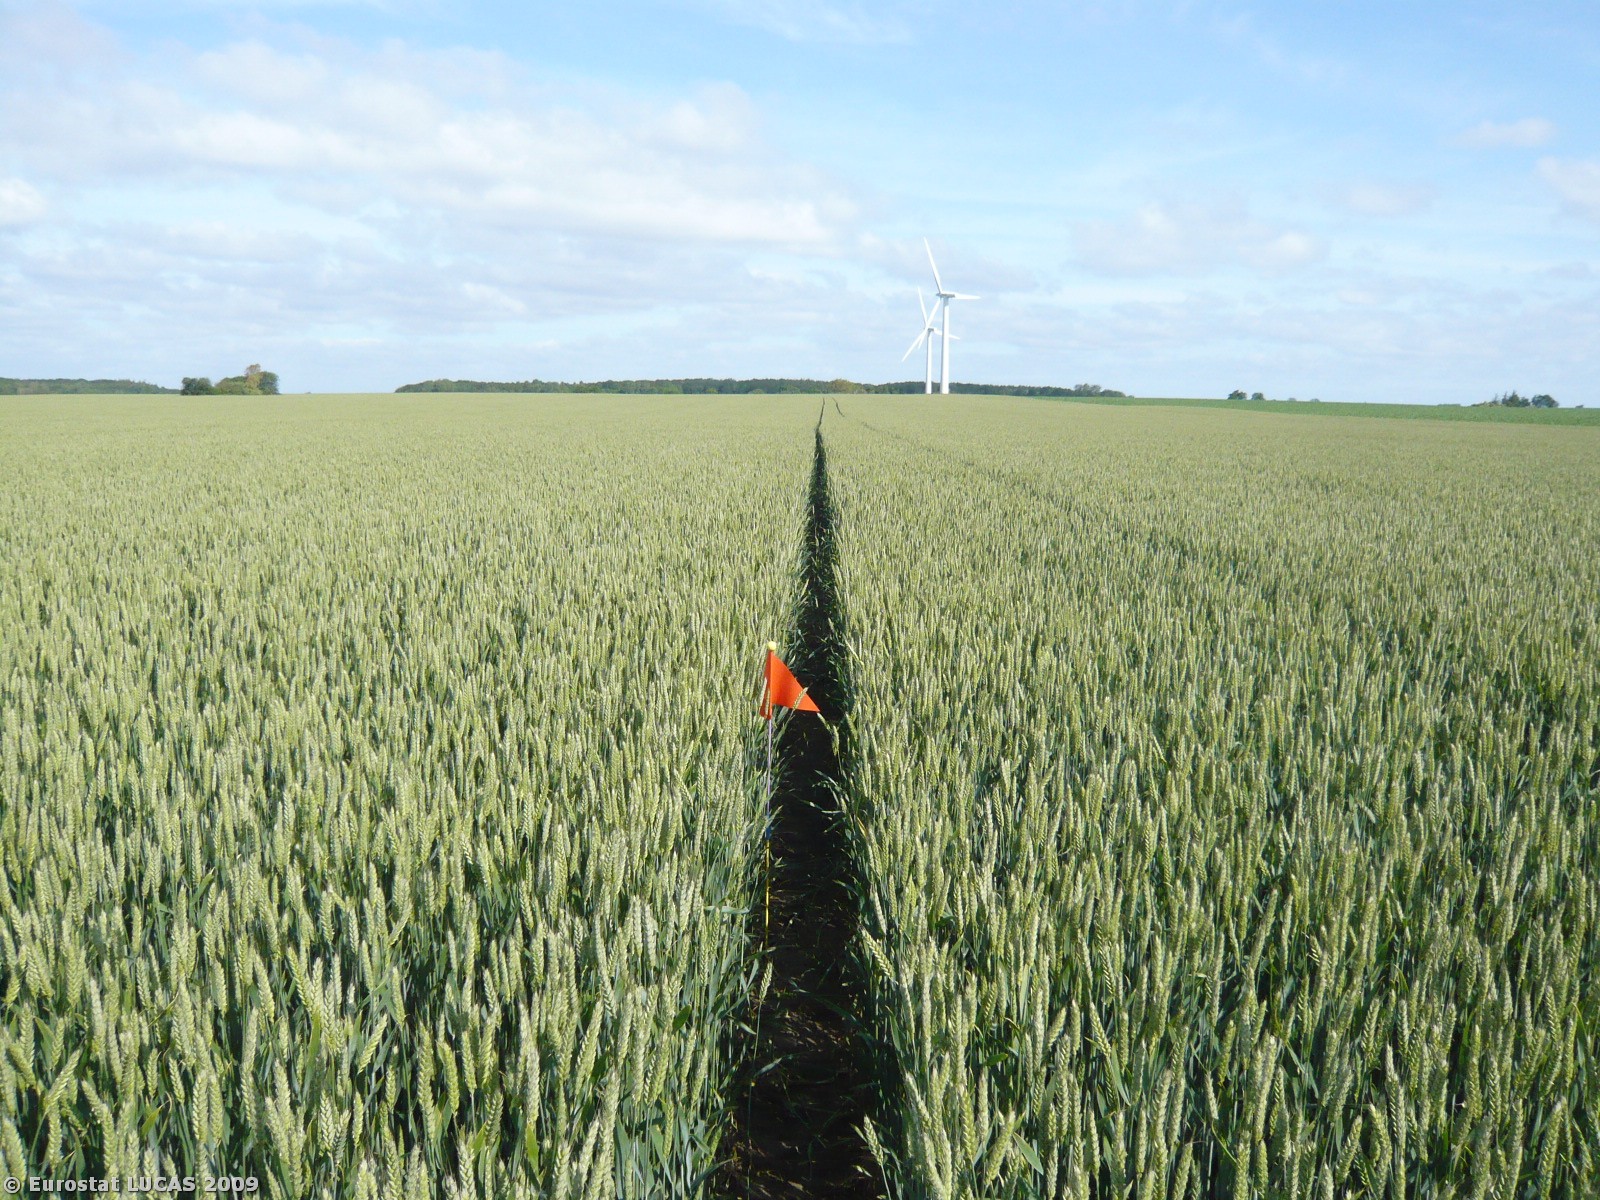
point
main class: Cropland
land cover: Common wheat
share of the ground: > 75 %
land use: Agriculture (excluding fallow land and kitchen gardens)
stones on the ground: < 10 %
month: June
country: DK
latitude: 54.9244
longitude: 11.1382
